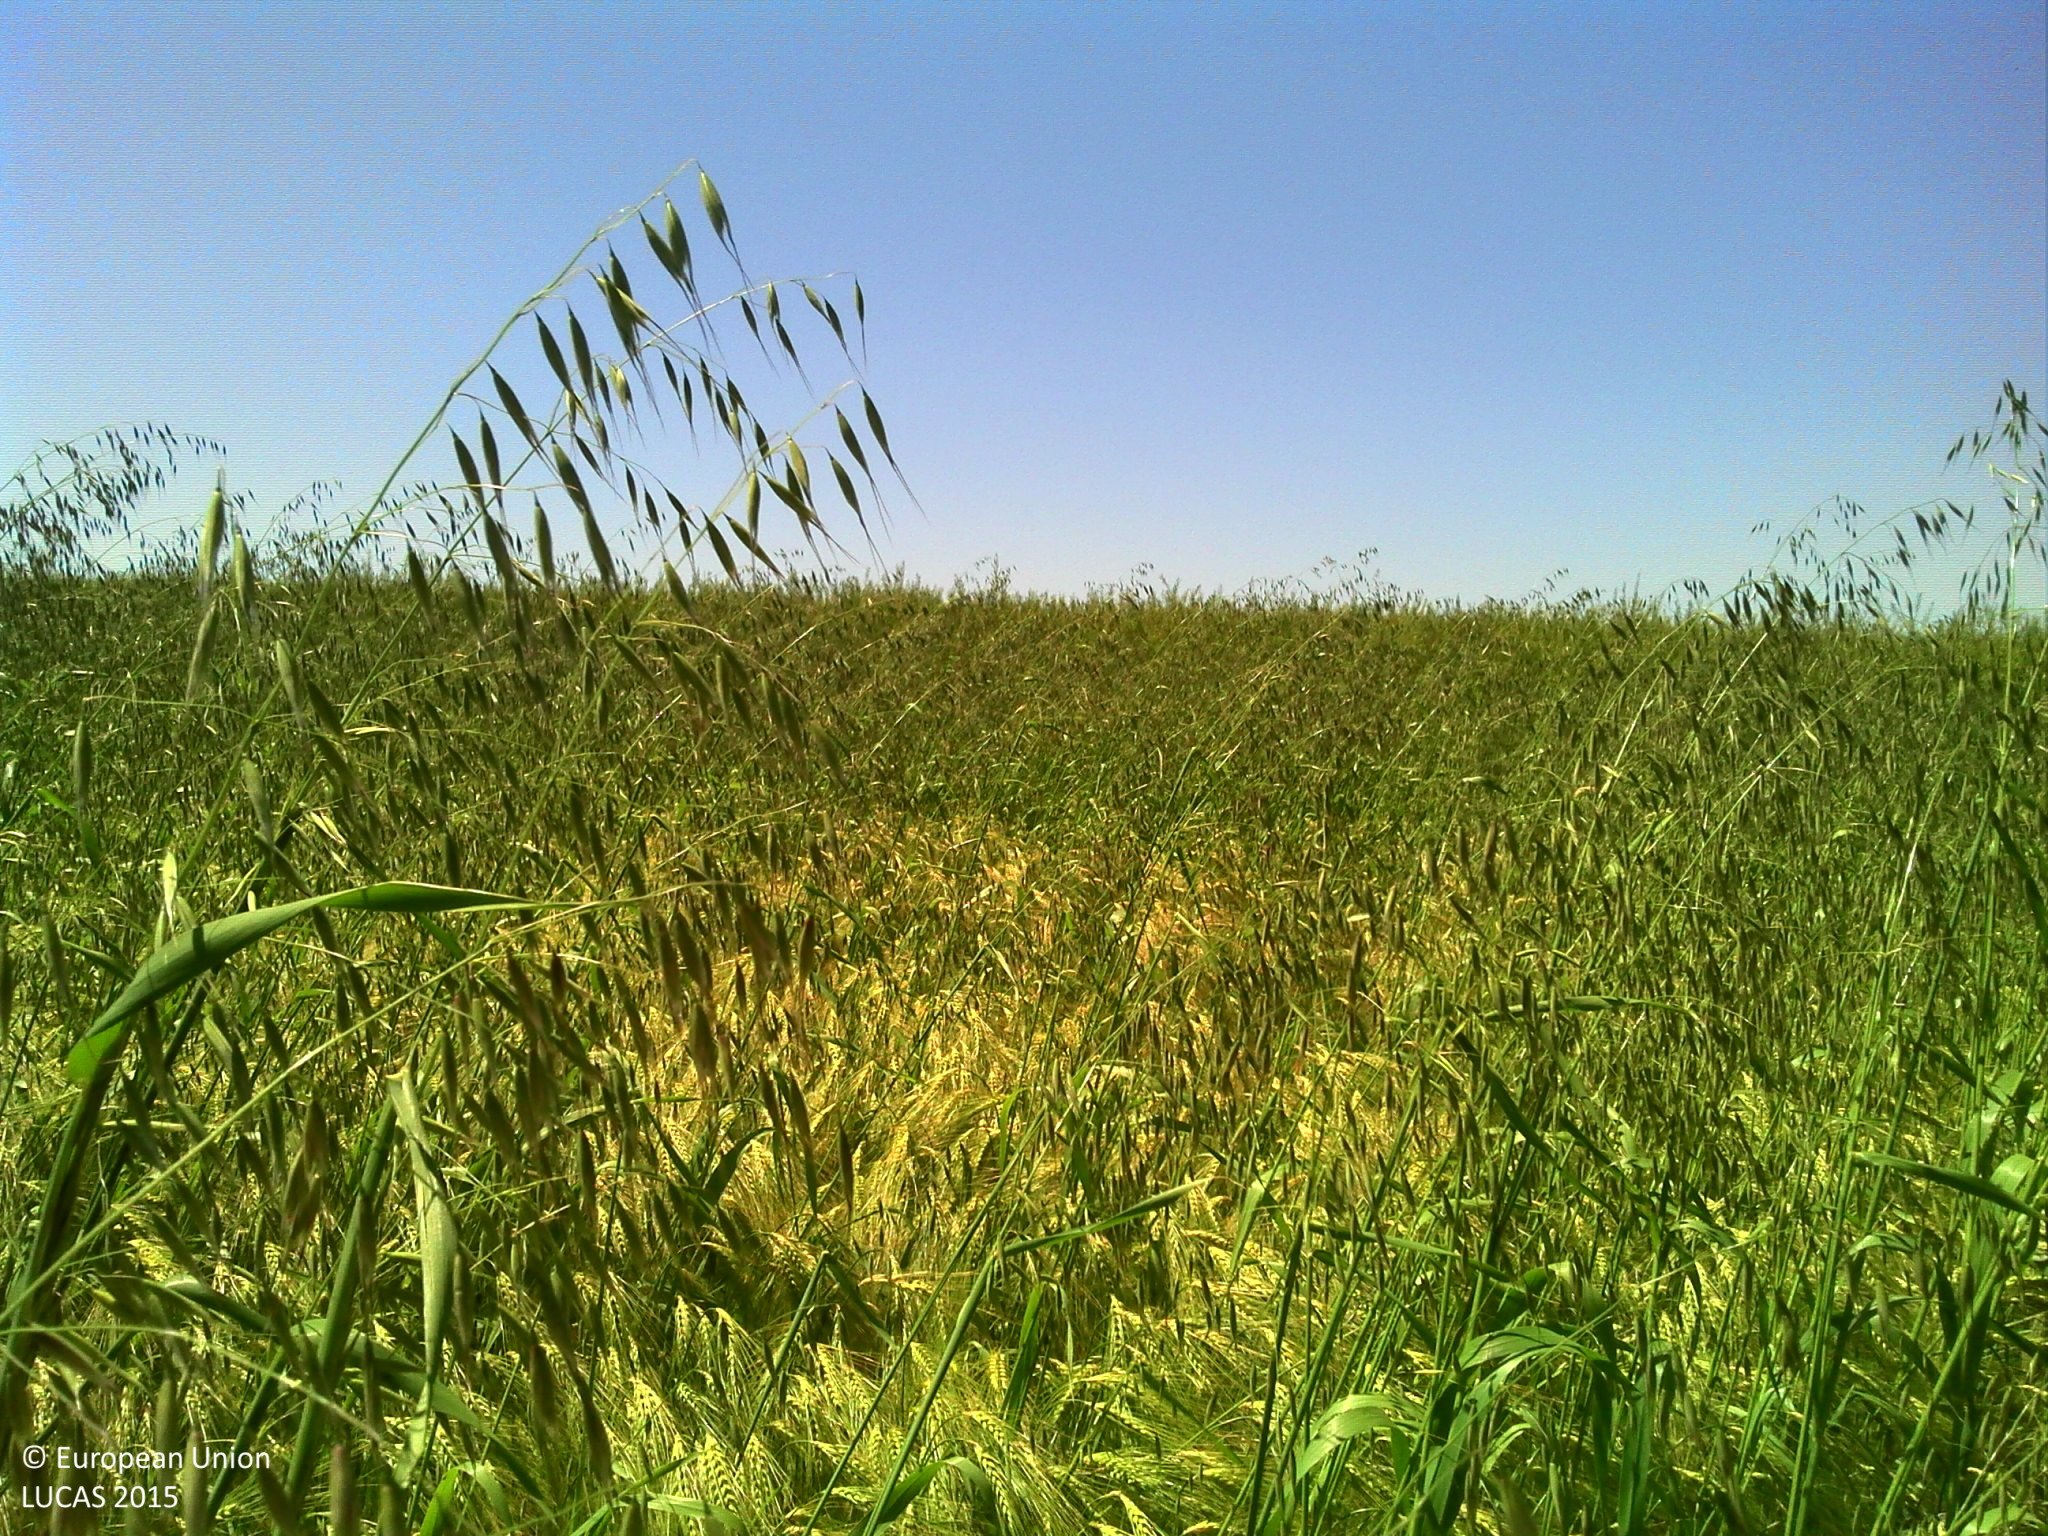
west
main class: Cropland
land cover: Mixed cereals for fodder
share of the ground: > 75 %
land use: Agriculture (excluding fallow land and kitchen gardens)
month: June
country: FR
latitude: 47.2287
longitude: 5.0479
